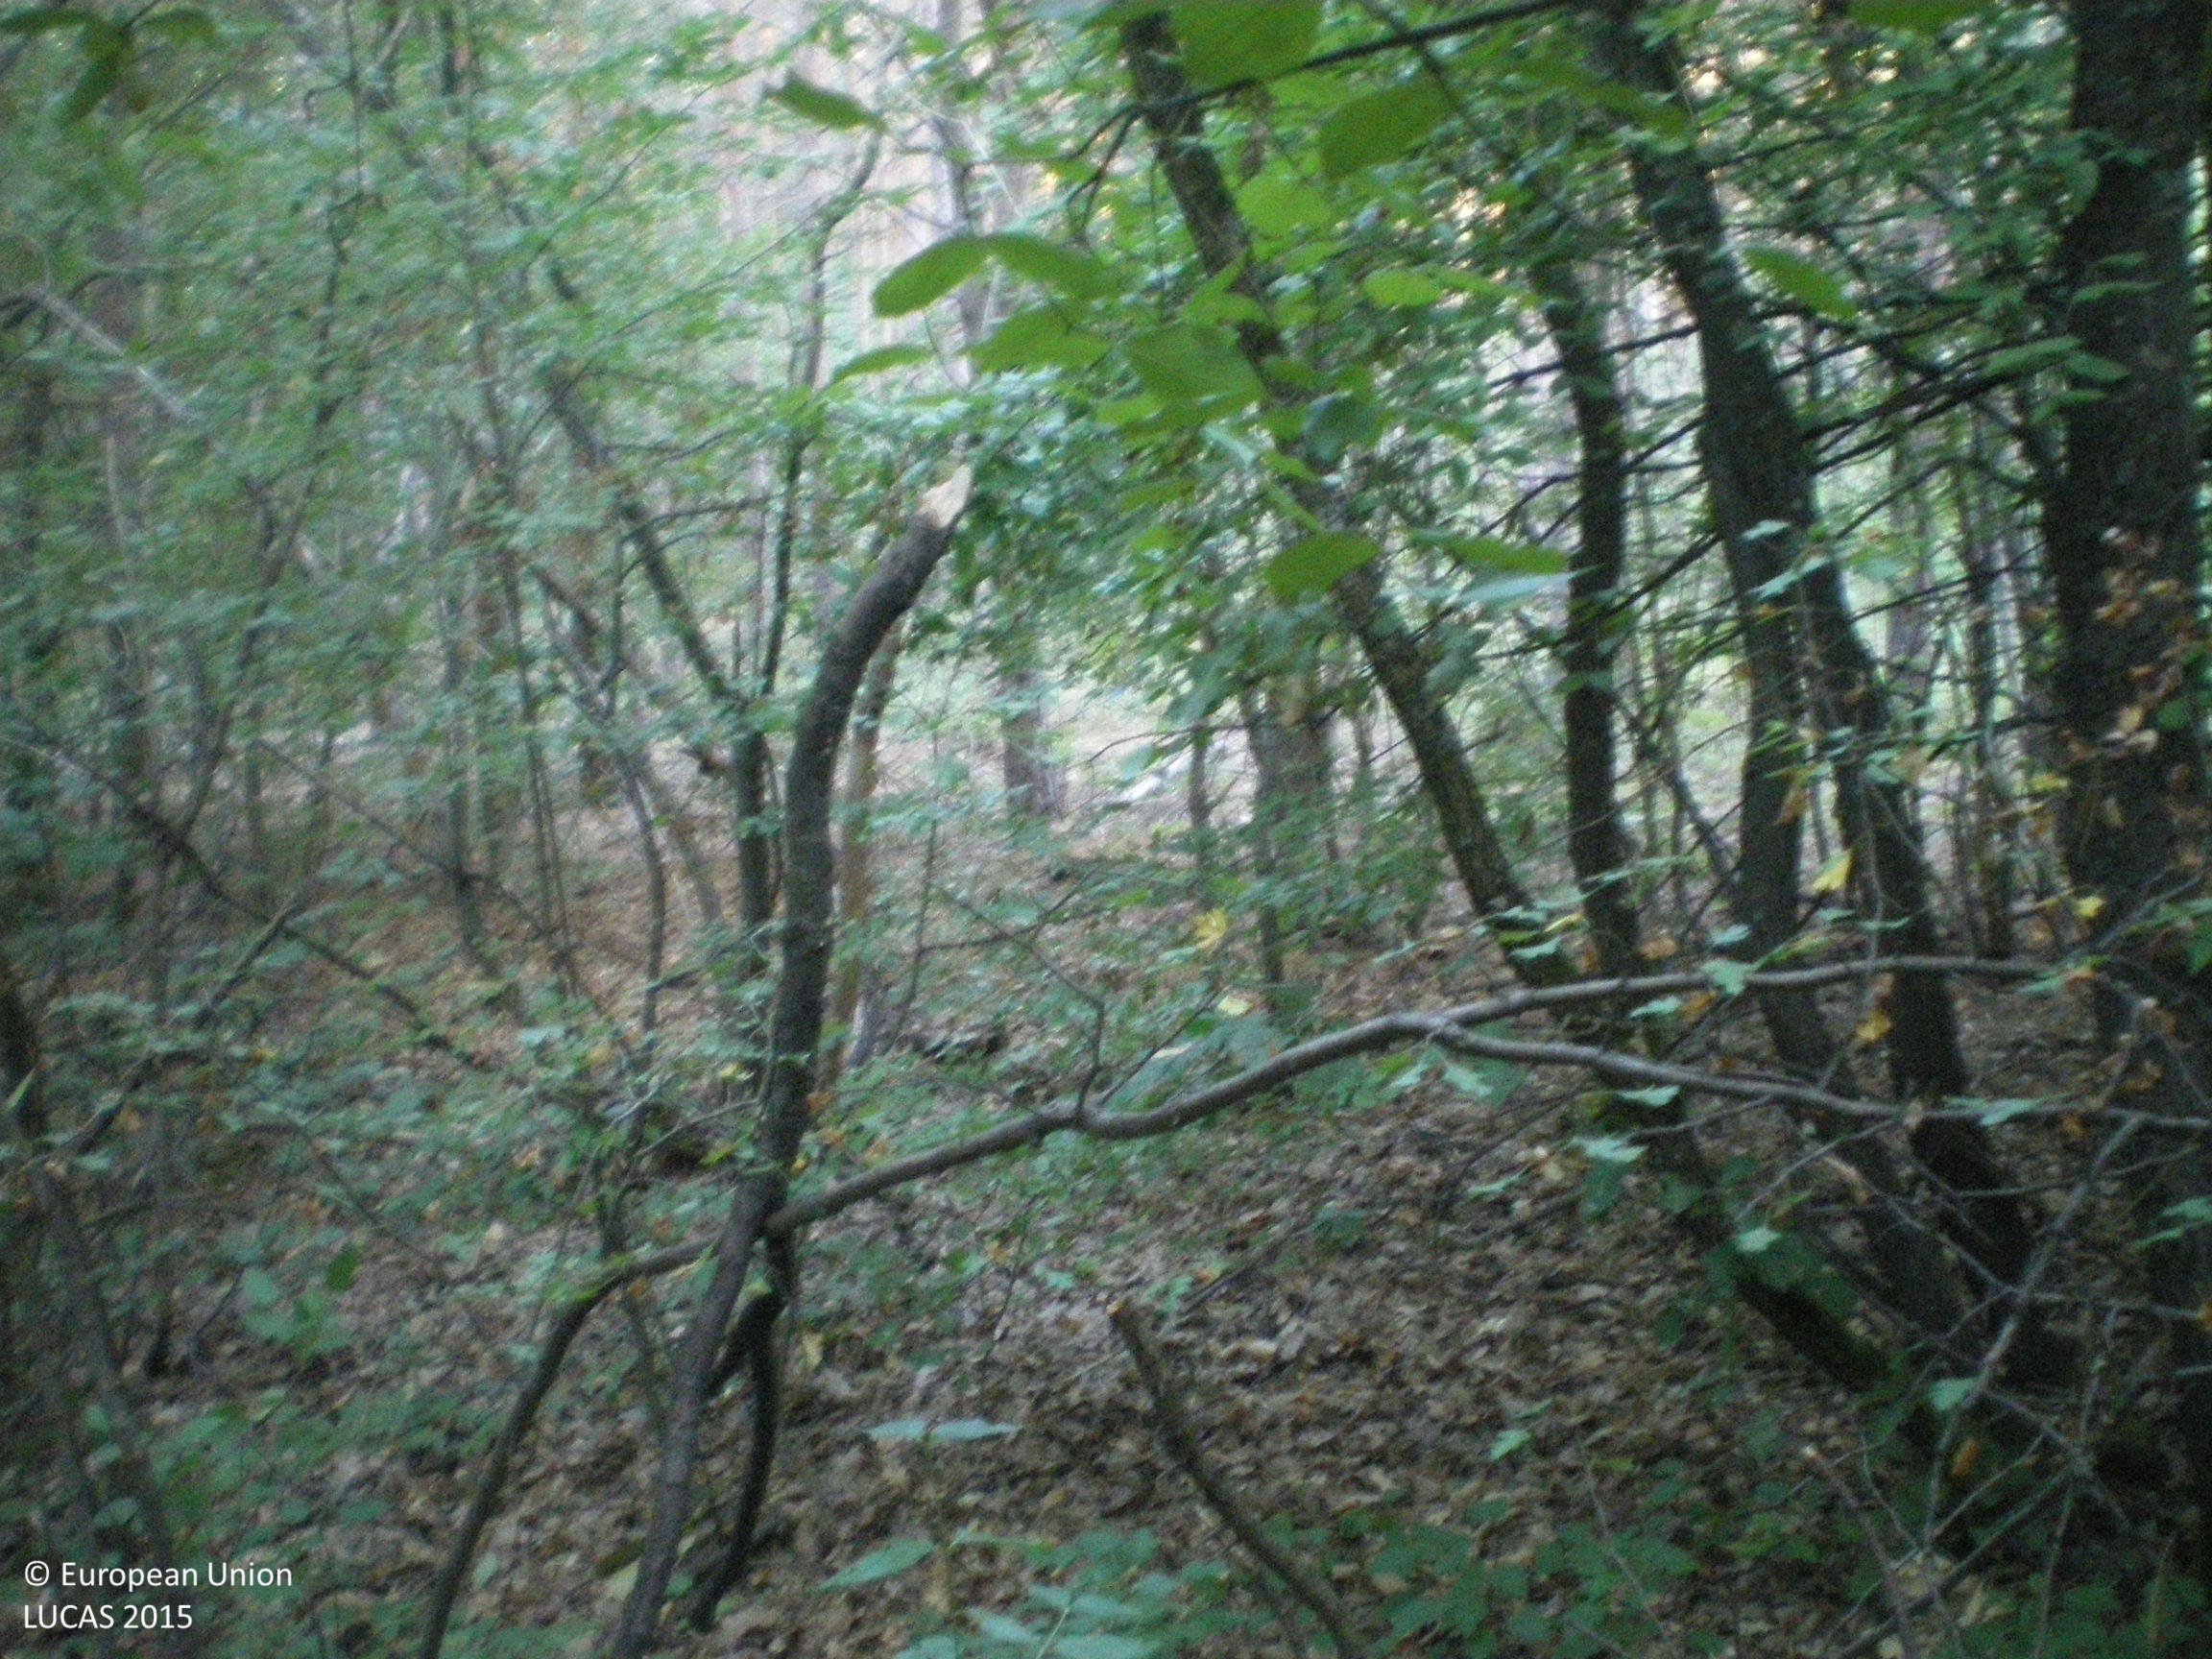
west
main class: Woodland
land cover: Broadleaved woodland
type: mesophytic deciduous forest
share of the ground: > 75 %
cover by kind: broadleaved forest trees 95 %, unconsolidated bare surface 5 %
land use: Forestry
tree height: > 5 m
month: August
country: BG
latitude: 42.4616
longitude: 25.5021
